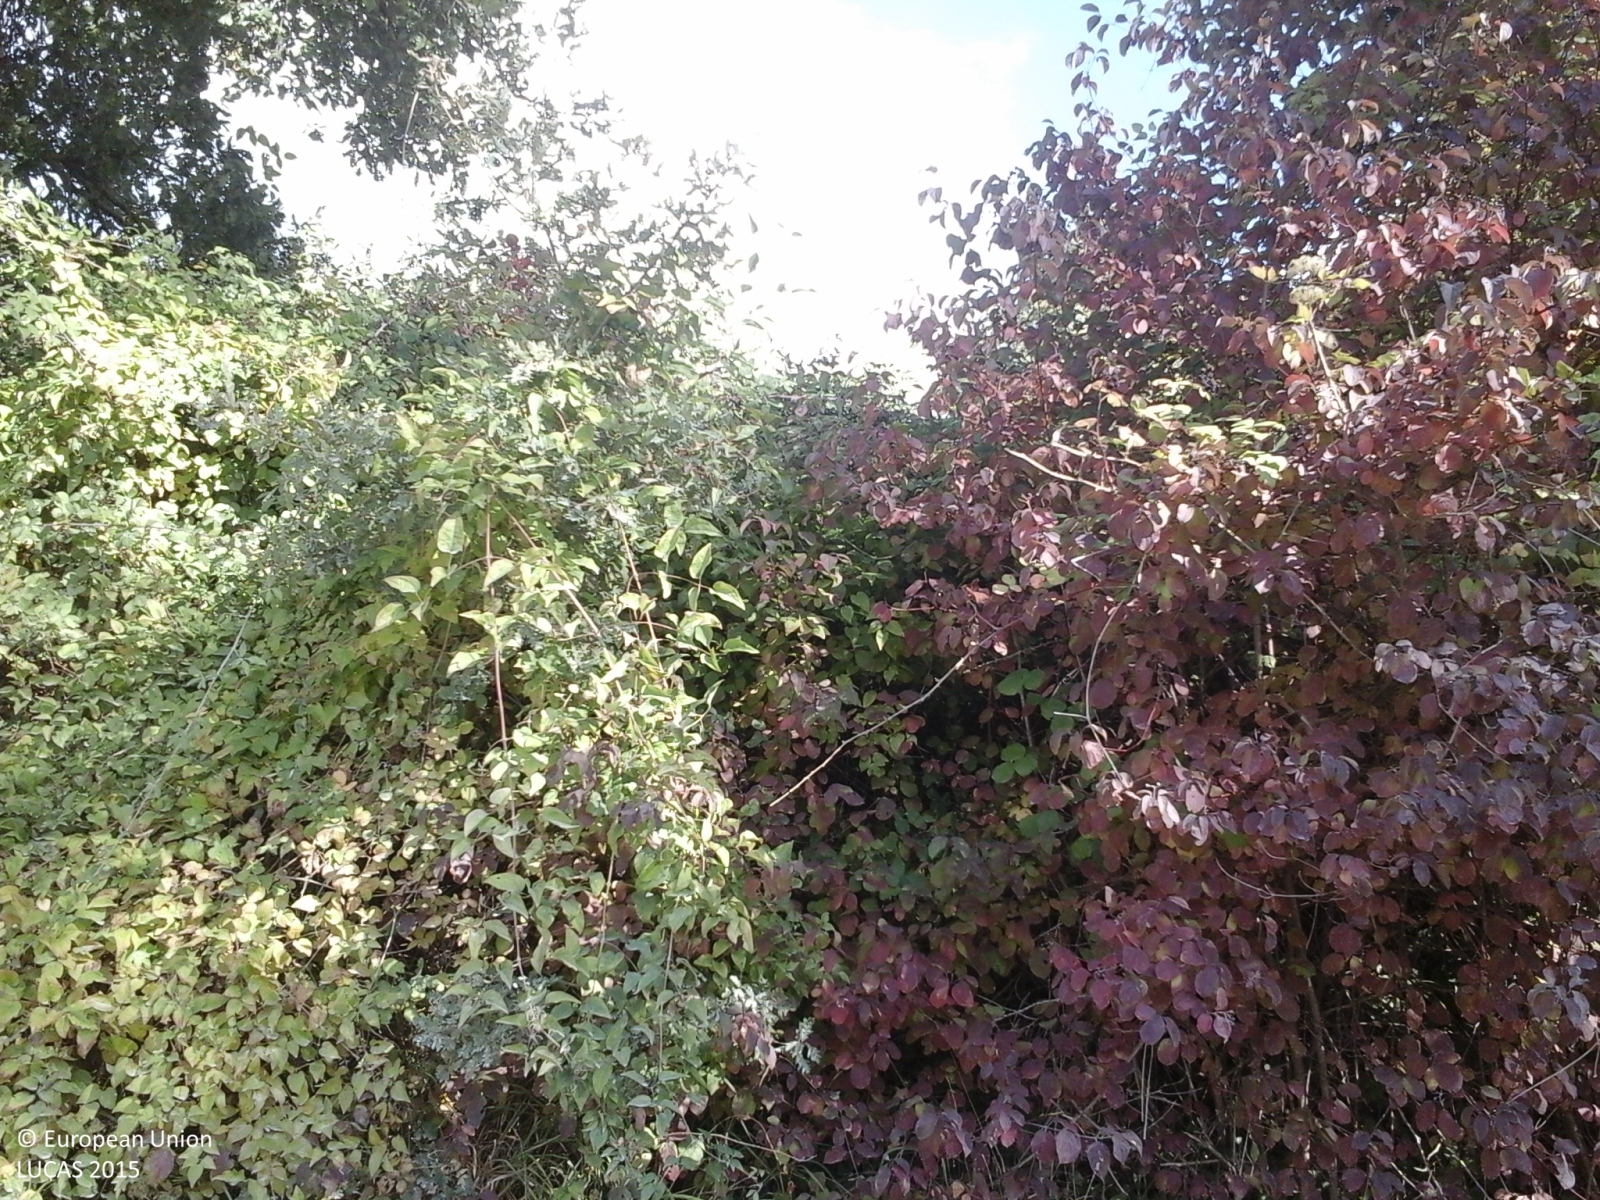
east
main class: Cropland
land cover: Olive groves
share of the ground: 50 - 75 %
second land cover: Spontaneously vegetated surfaces
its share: > 75 %
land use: Agriculture (excluding fallow land and kitchen gardens)
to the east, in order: Olive groves; Spontaneously vegetated surfaces; Electric lines; Olive groves; Fences; Grass margins; Tracks; Grass margins; Broadleaved woodland; Shrubland with sparse tree cover; Tracks; Broadleaved woodland; Paved roads, cycling and walking lanes; Broadleaved woodland; Electric lines; Ditches and canals; Tracks
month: October
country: IT
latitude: 43.2438
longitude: 12.2228
